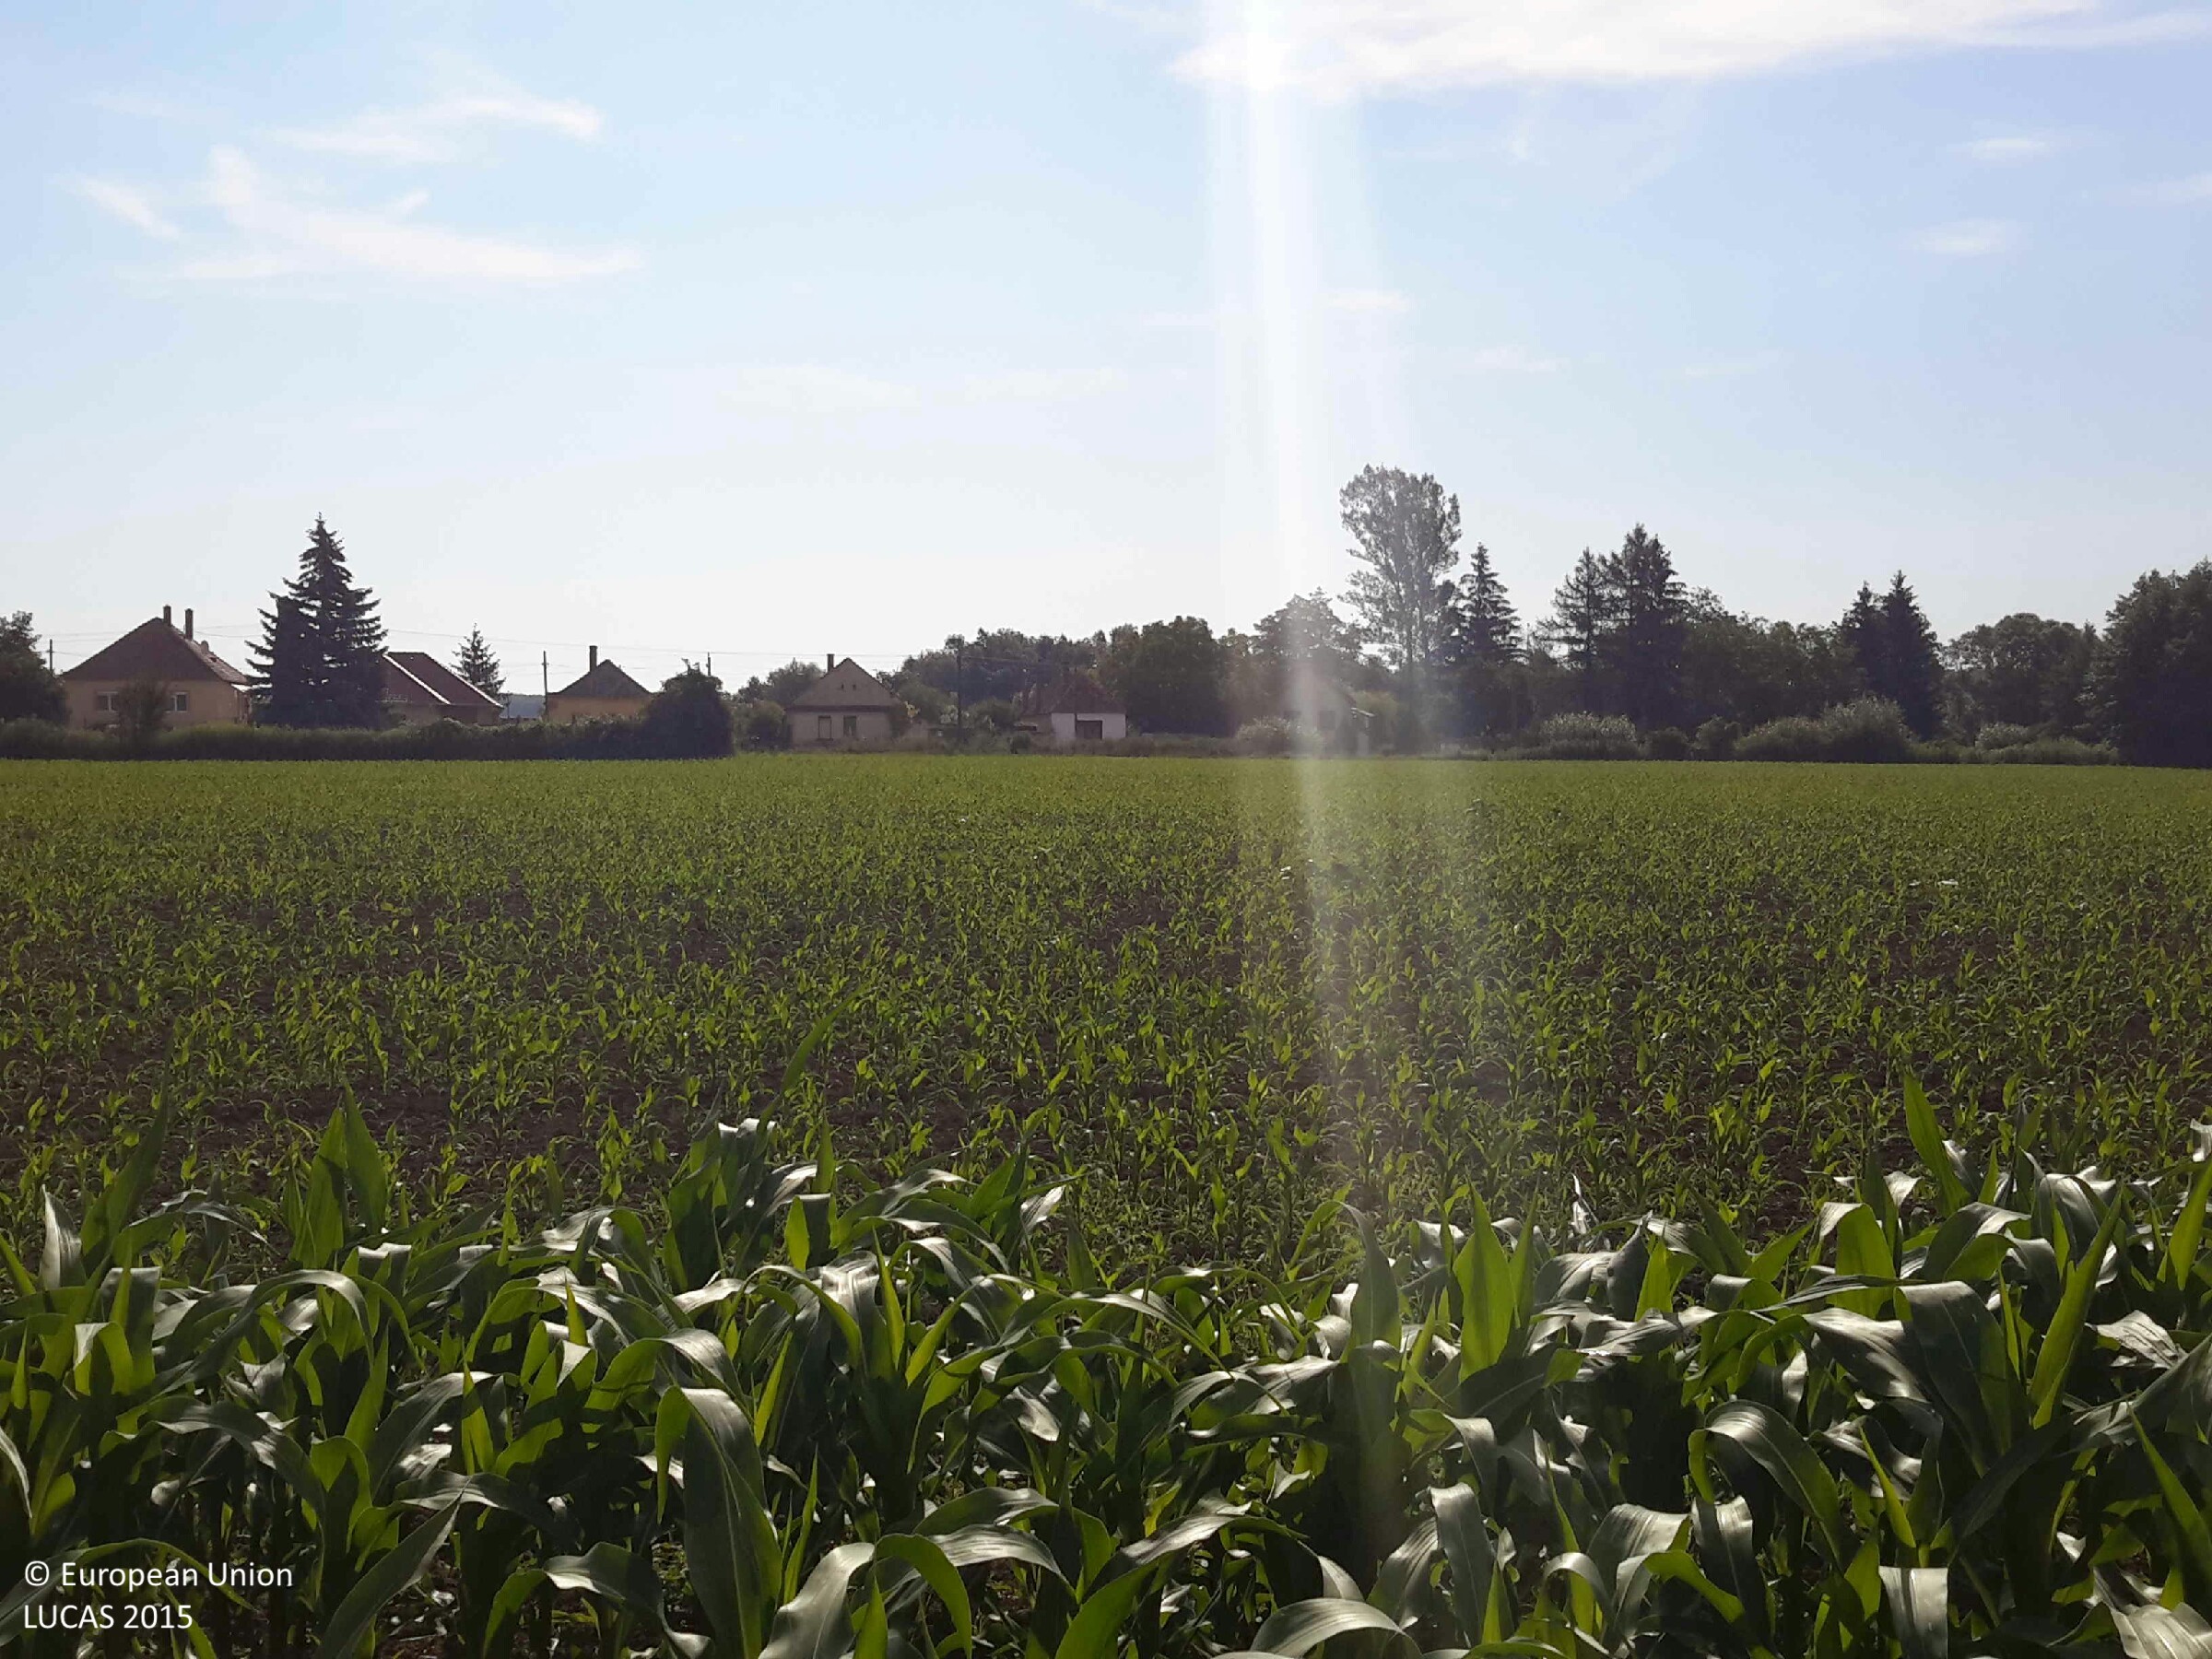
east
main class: Cropland
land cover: Maize
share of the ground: > 75 %
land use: Agriculture (excluding fallow land and kitchen gardens)
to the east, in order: Maize; Spontaneously vegetated surfaces; Ditches and canals; Artificial constructions in urban areas
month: June
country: HU
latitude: 47.2469
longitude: 17.4719
